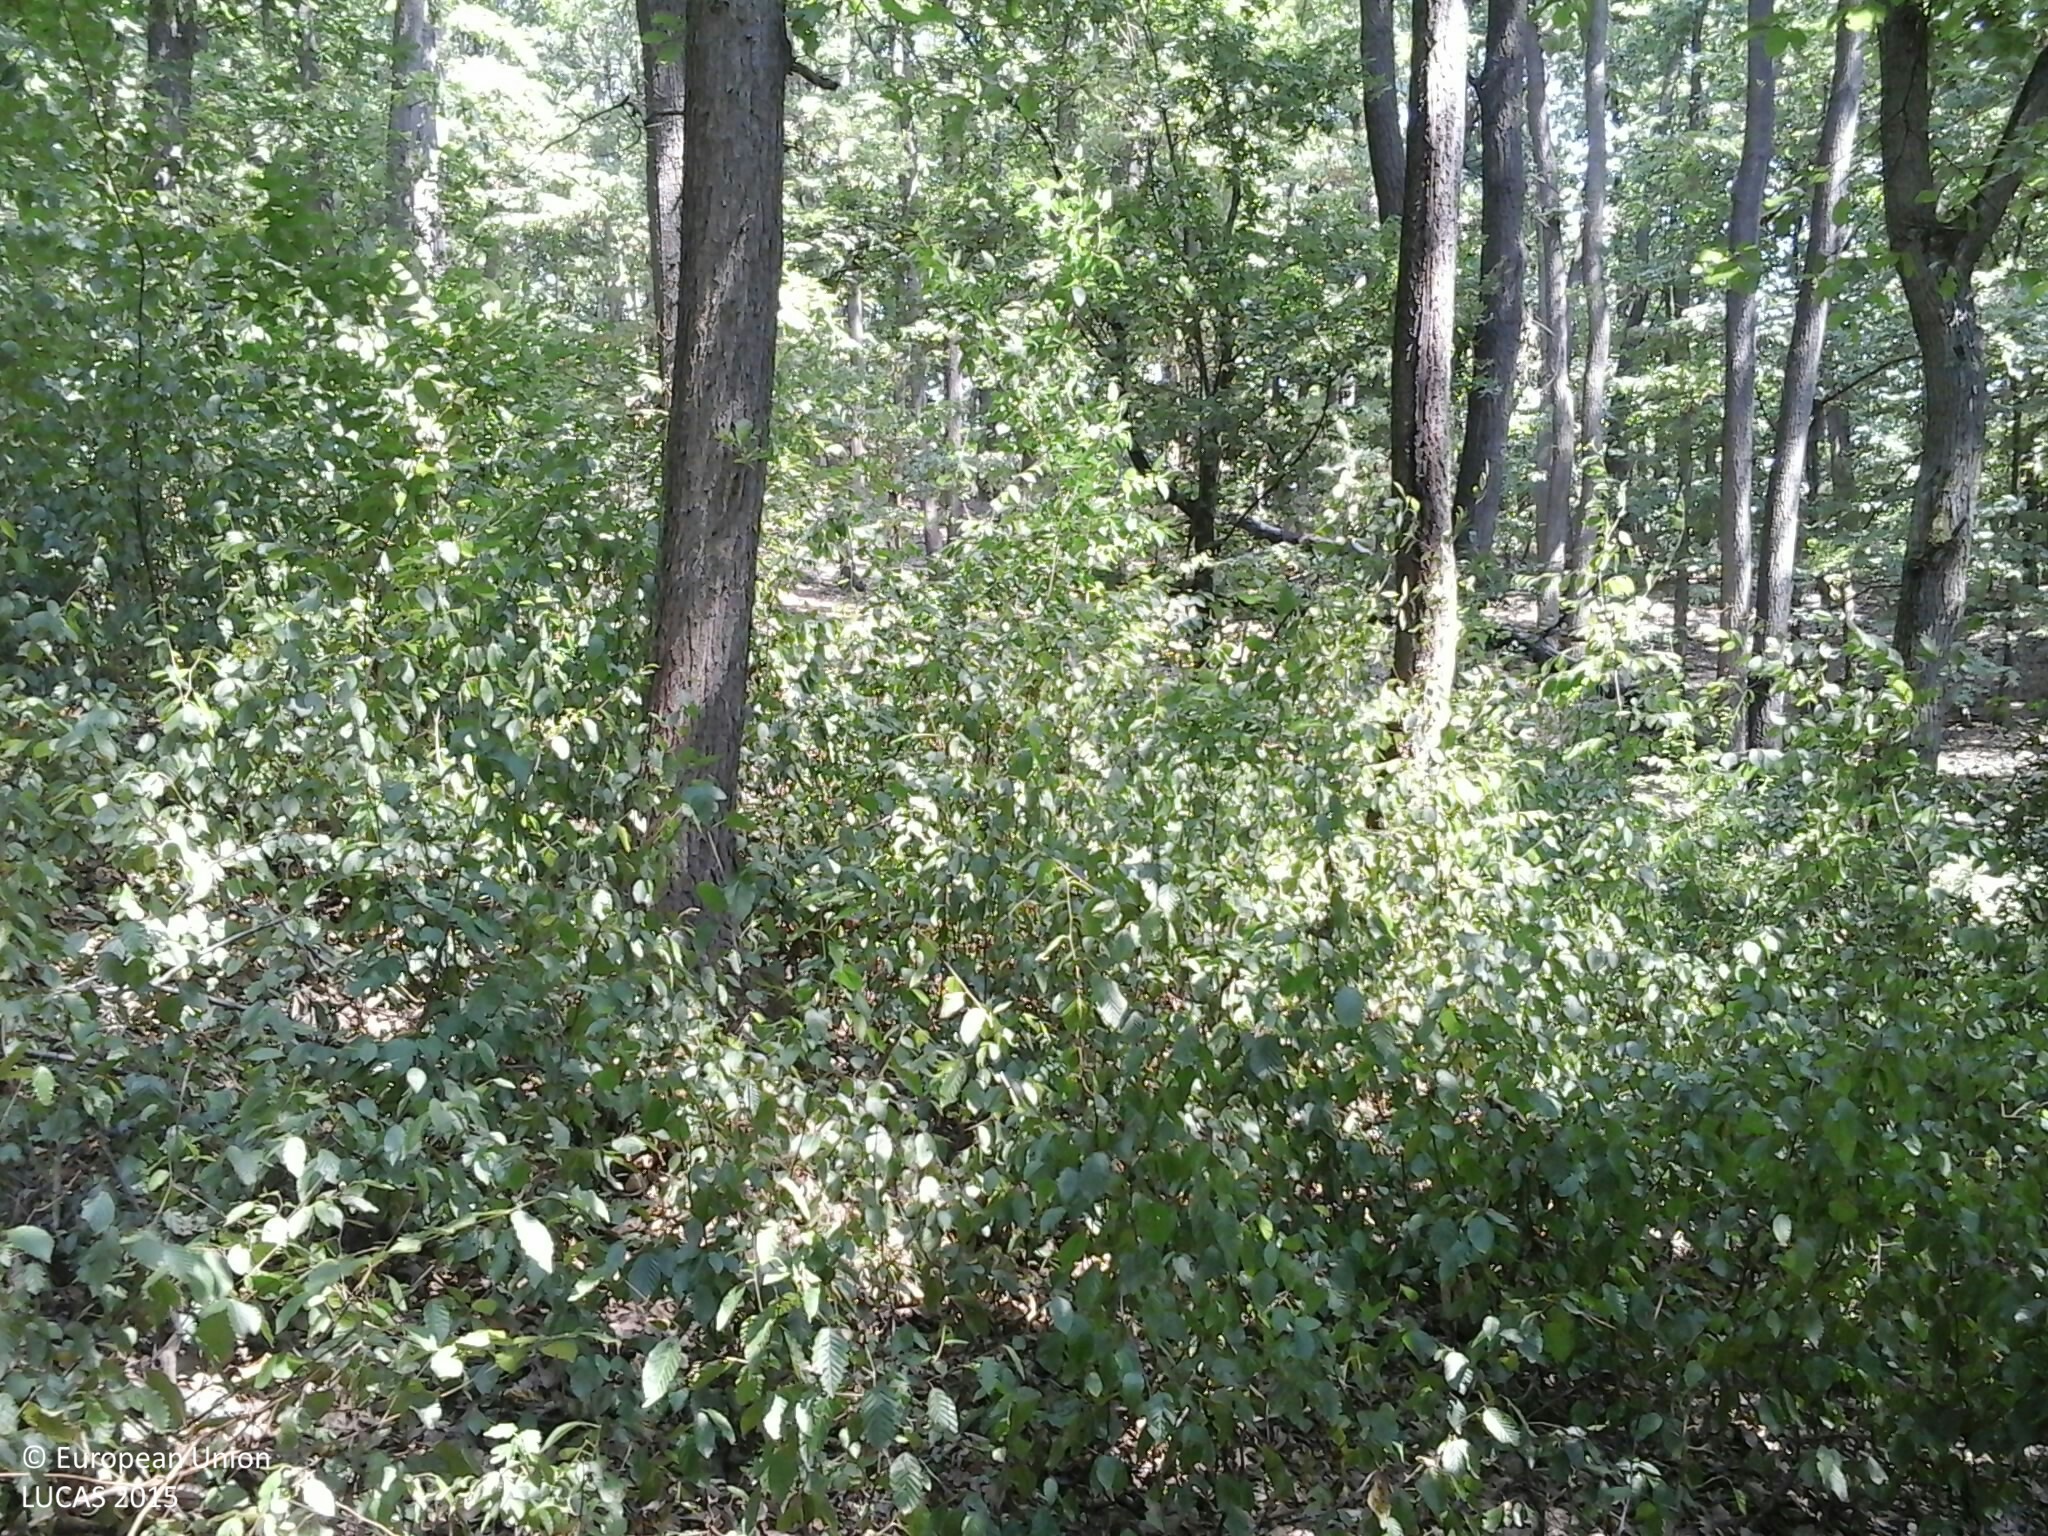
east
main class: Woodland
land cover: Broadleaved woodland
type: mesophytic deciduous forest
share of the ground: > 75 %
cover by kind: broadleaved forest trees 100 %
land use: Forestry
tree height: > 5 m
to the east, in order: Broadleaved woodland
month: August
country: HU
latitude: 48.3208
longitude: 20.4860
